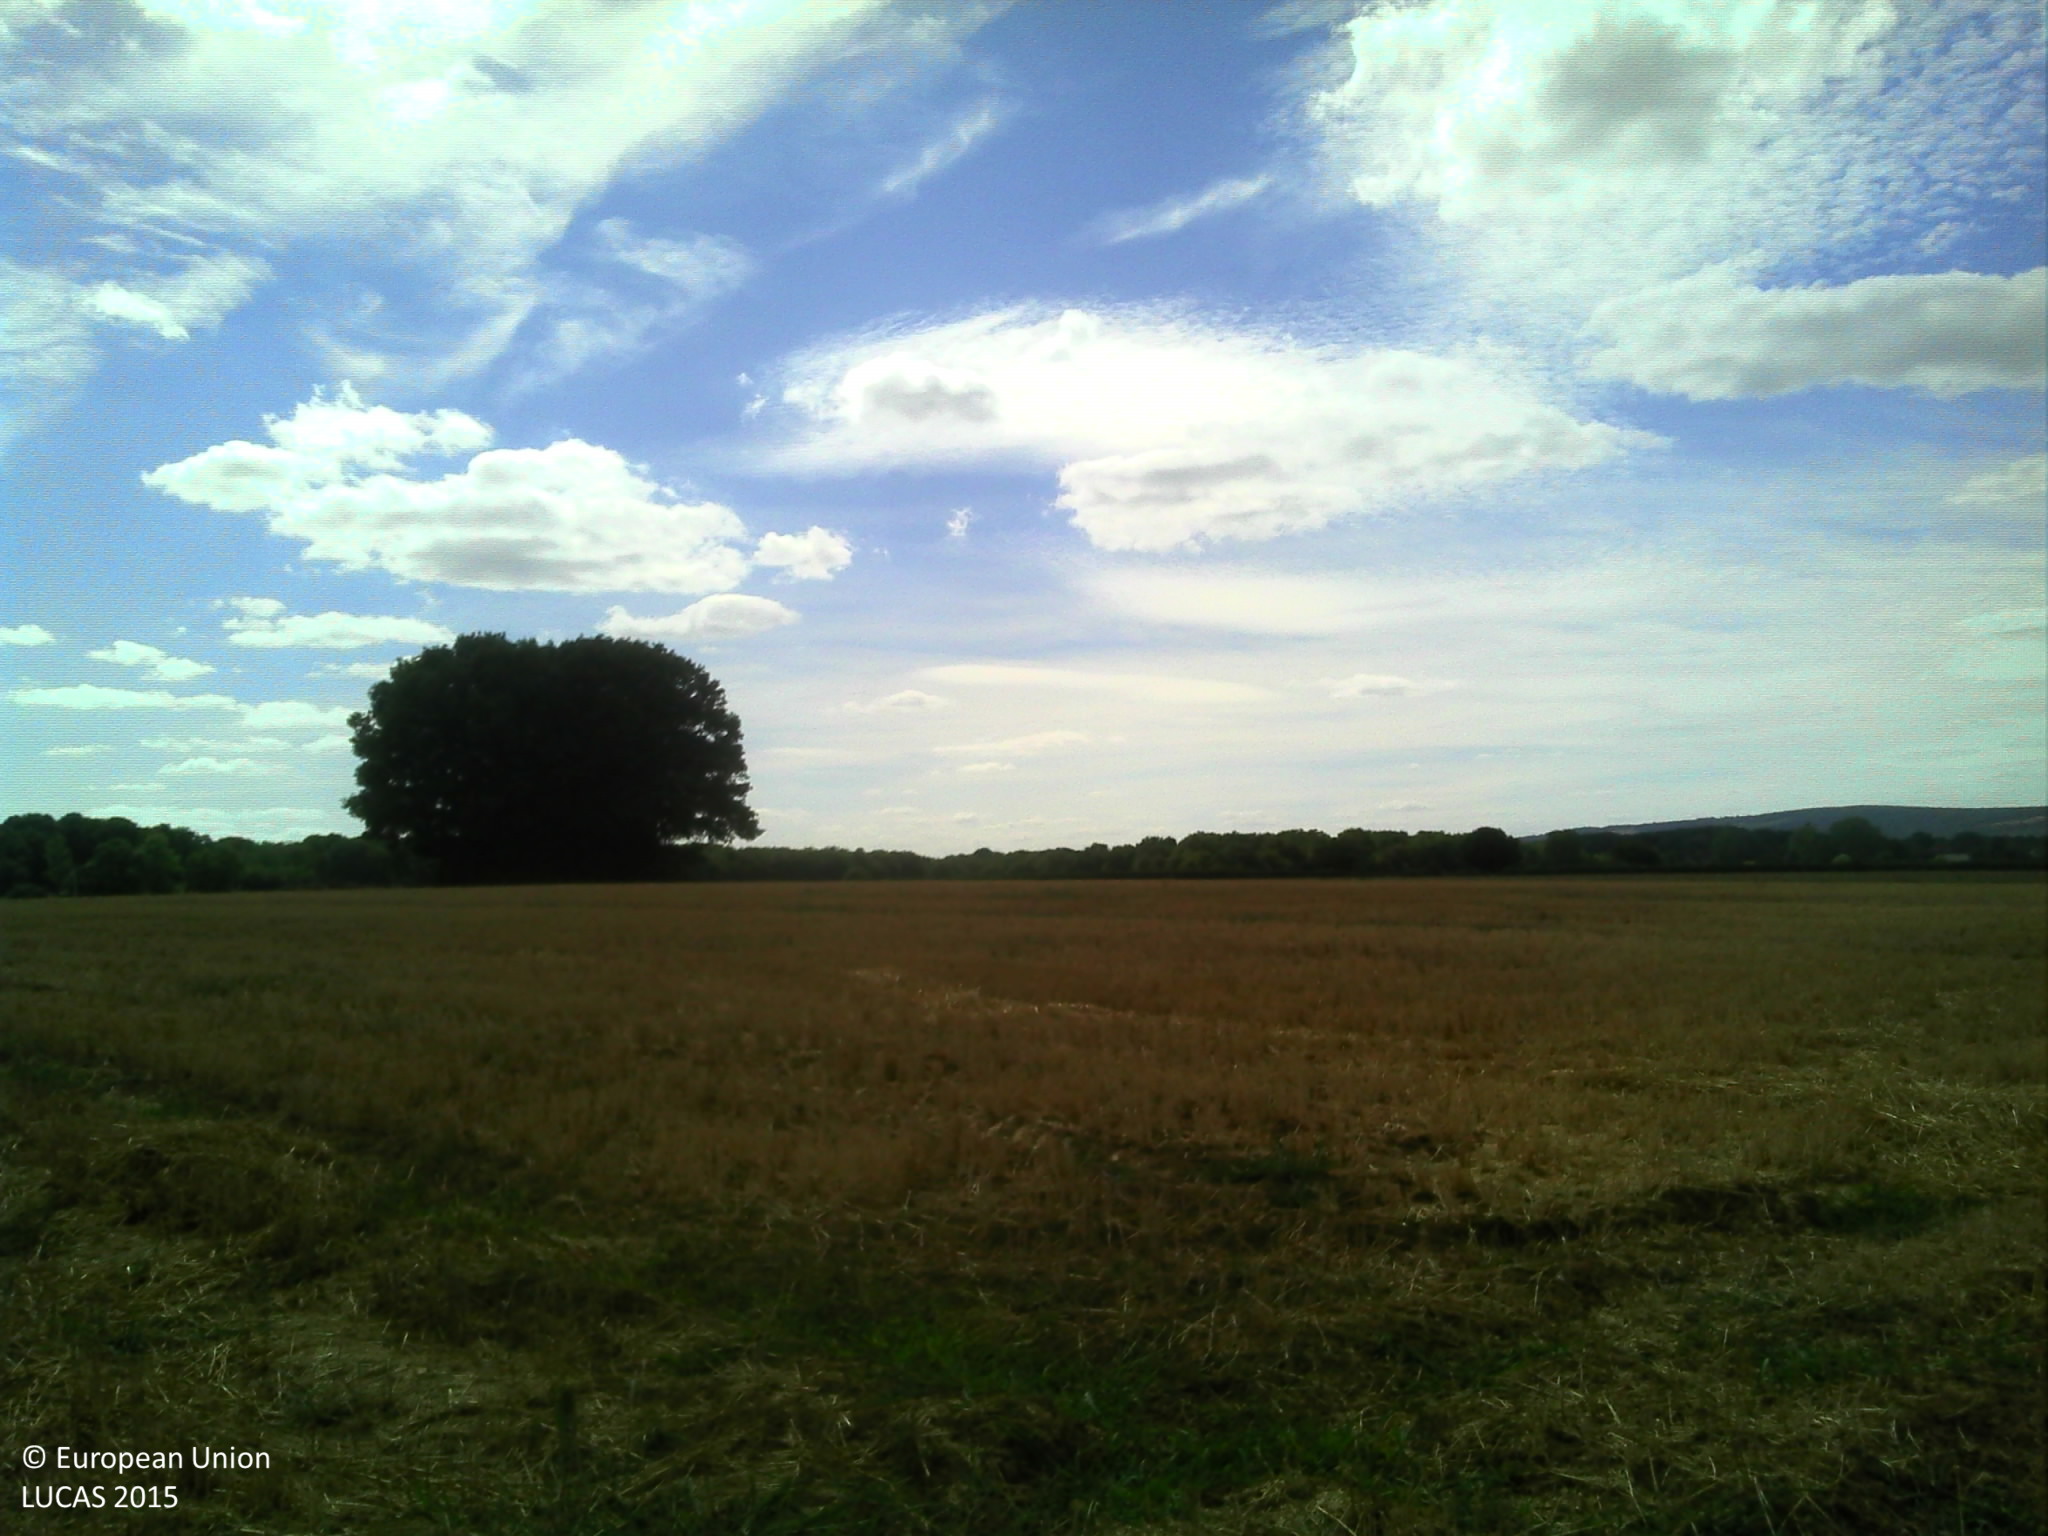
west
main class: Cropland
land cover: Common wheat
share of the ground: > 75 %
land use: Agriculture (excluding fallow land and kitchen gardens)
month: July
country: FR
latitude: 46.7663
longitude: 4.8028
